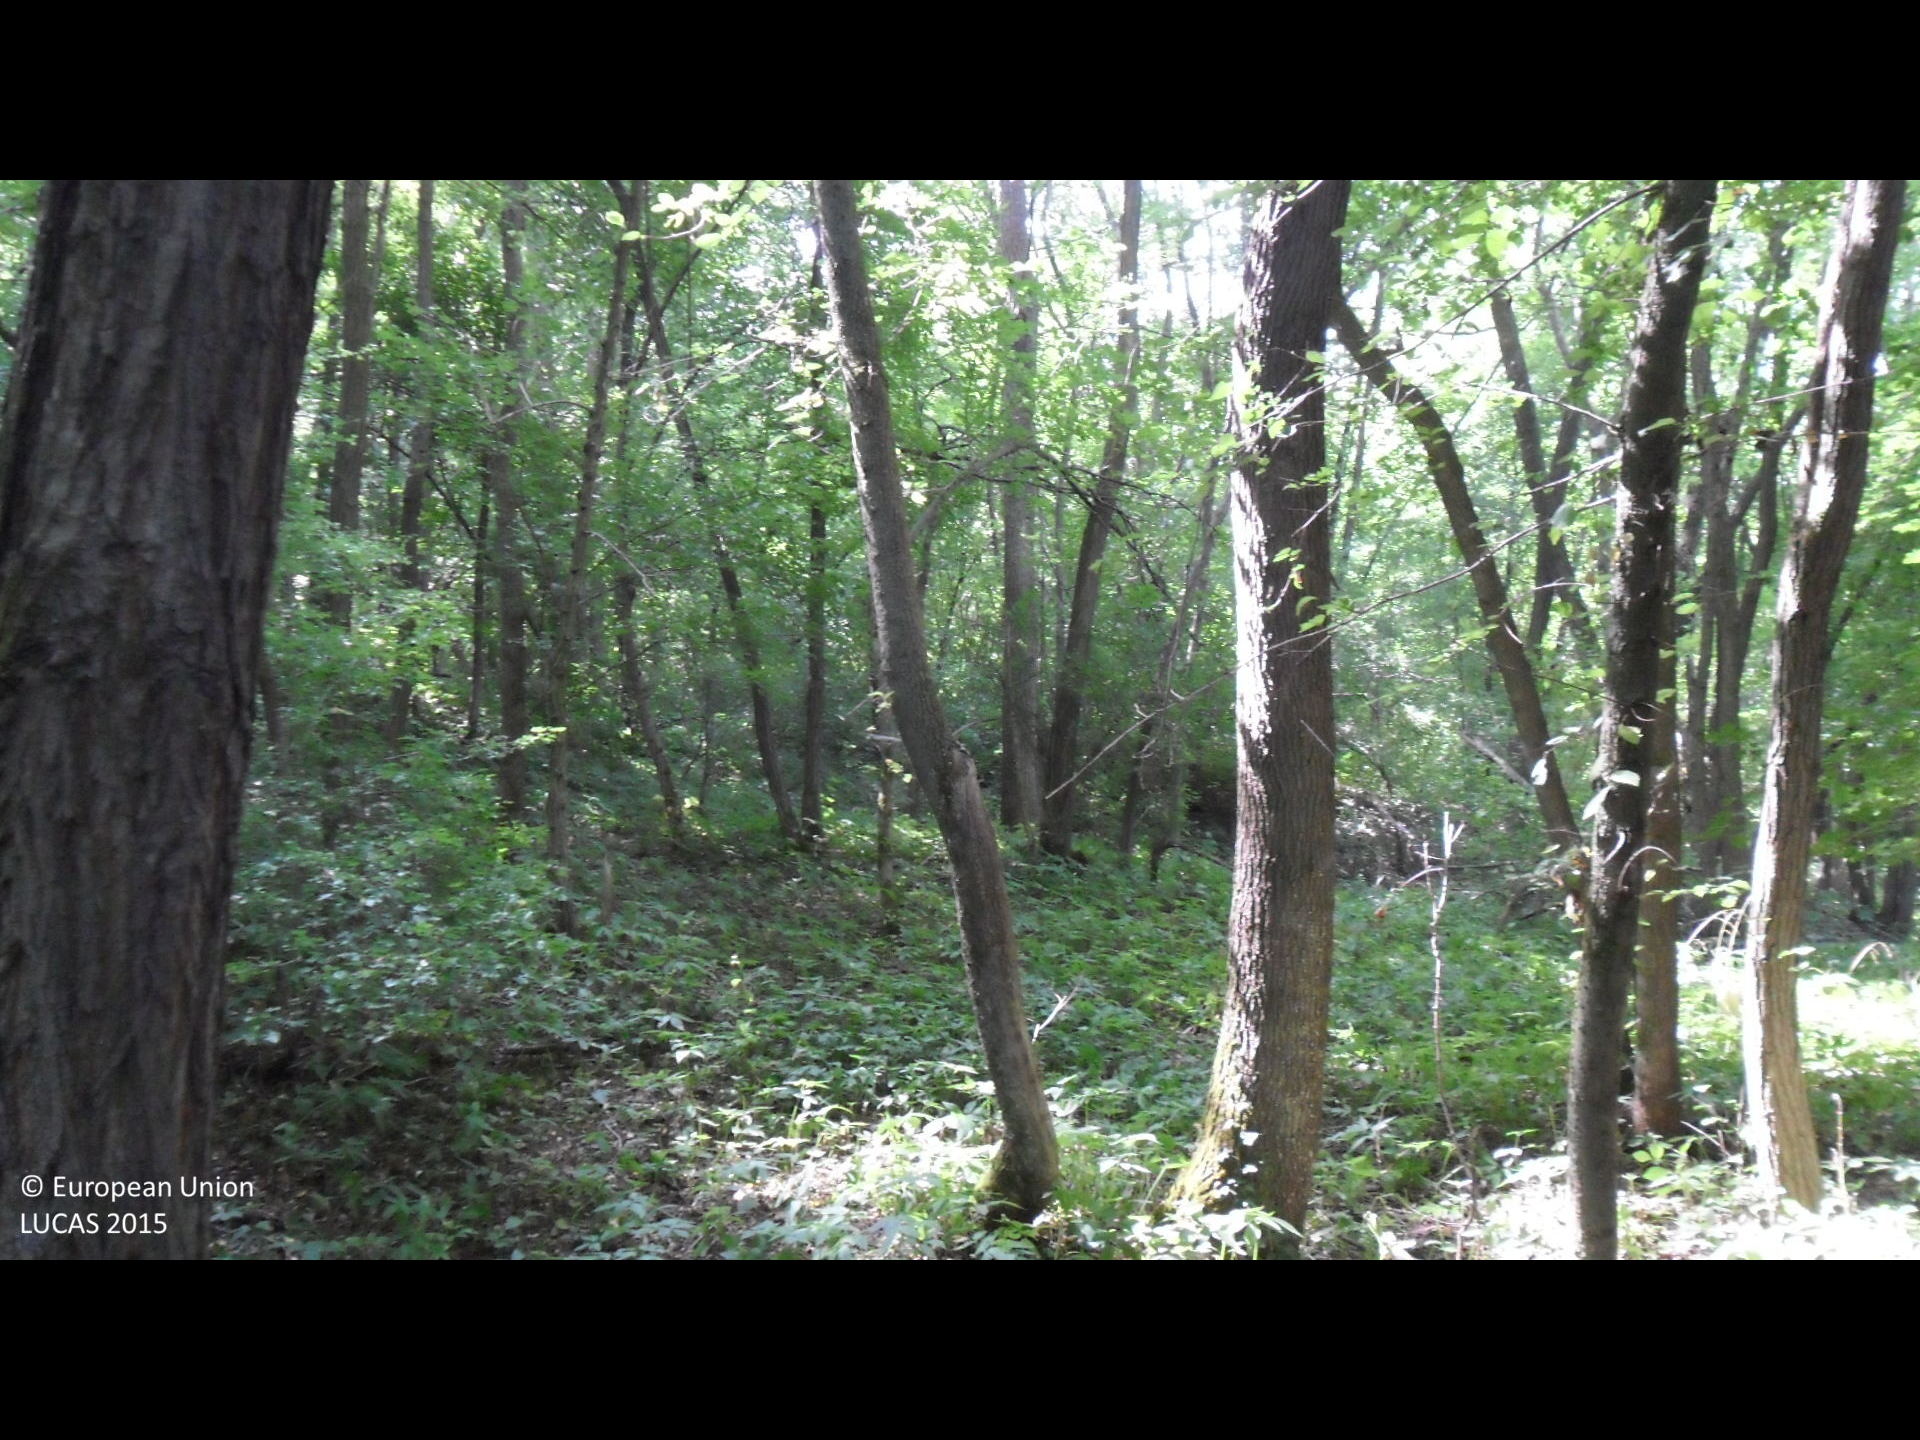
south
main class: Woodland
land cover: Broadleaved woodland
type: mesophytic deciduous forest
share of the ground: > 75 %
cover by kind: broadleaved forest trees 100 %
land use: Forestry
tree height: > 5 m
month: August
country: BG
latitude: 43.2718
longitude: 26.2994
